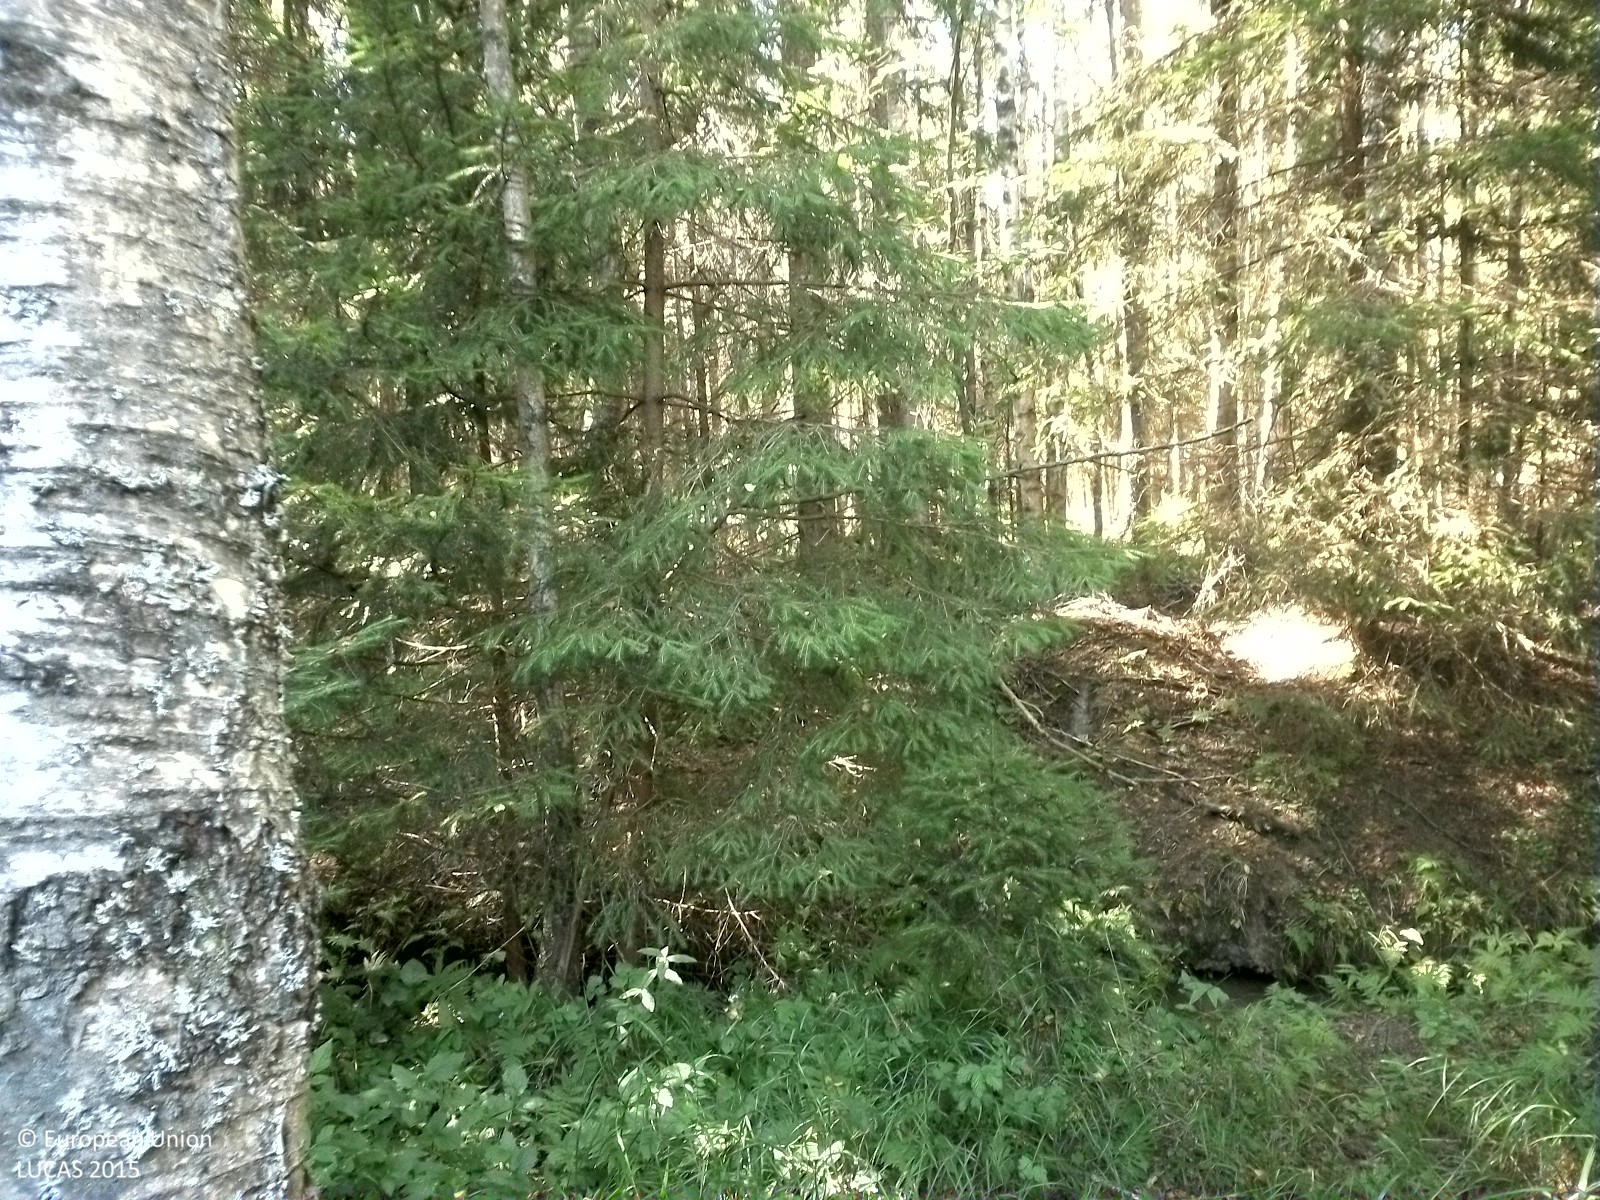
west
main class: Woodland
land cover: Spruce dominated mixed woodland
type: boreal forest
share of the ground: 50 - 75 %
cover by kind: shrubs 45 %, coniferous forest trees 30 %, broadleaved forest trees 25 %
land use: Forestry
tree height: > 5 m
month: August
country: SE
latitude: 59.2318
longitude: 14.8462
